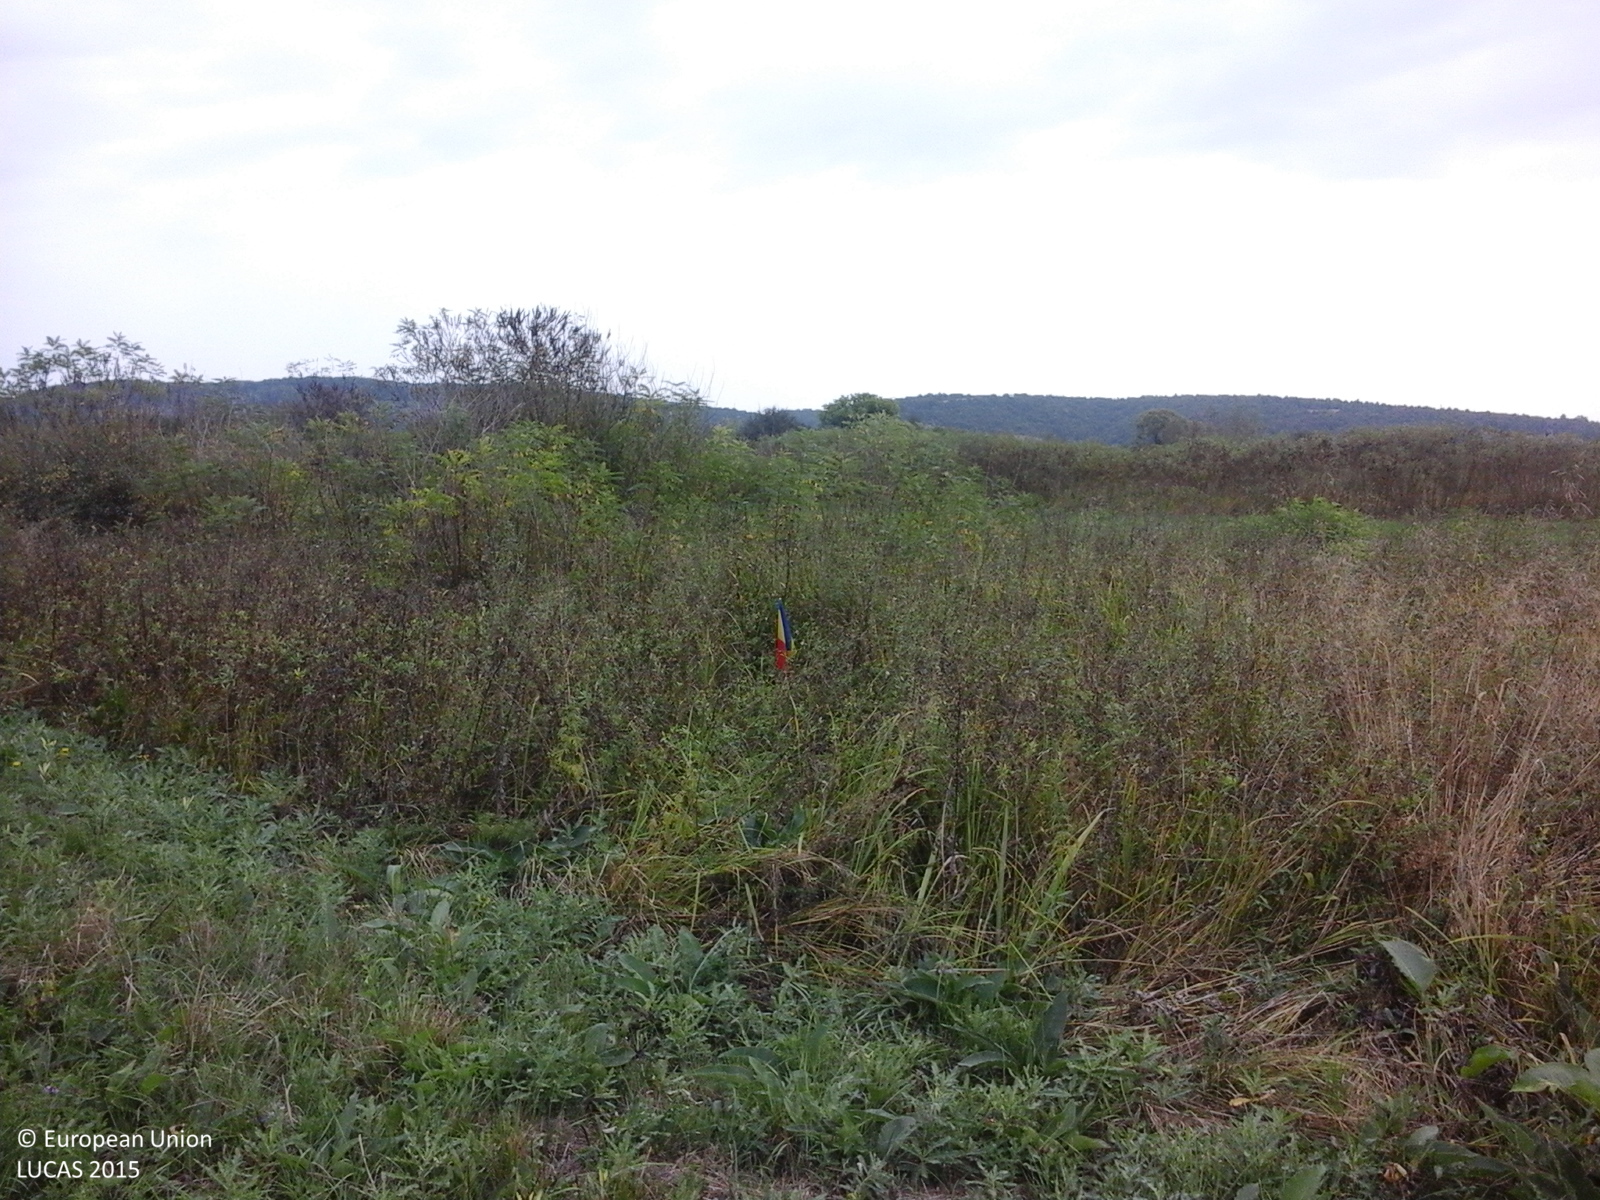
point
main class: Grassland
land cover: Spontaneously vegetated surfaces
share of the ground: > 75 %
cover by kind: herbaceous plants 100 %
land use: Fallow land
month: September
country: RO
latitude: 45.9936
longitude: 22.2195
